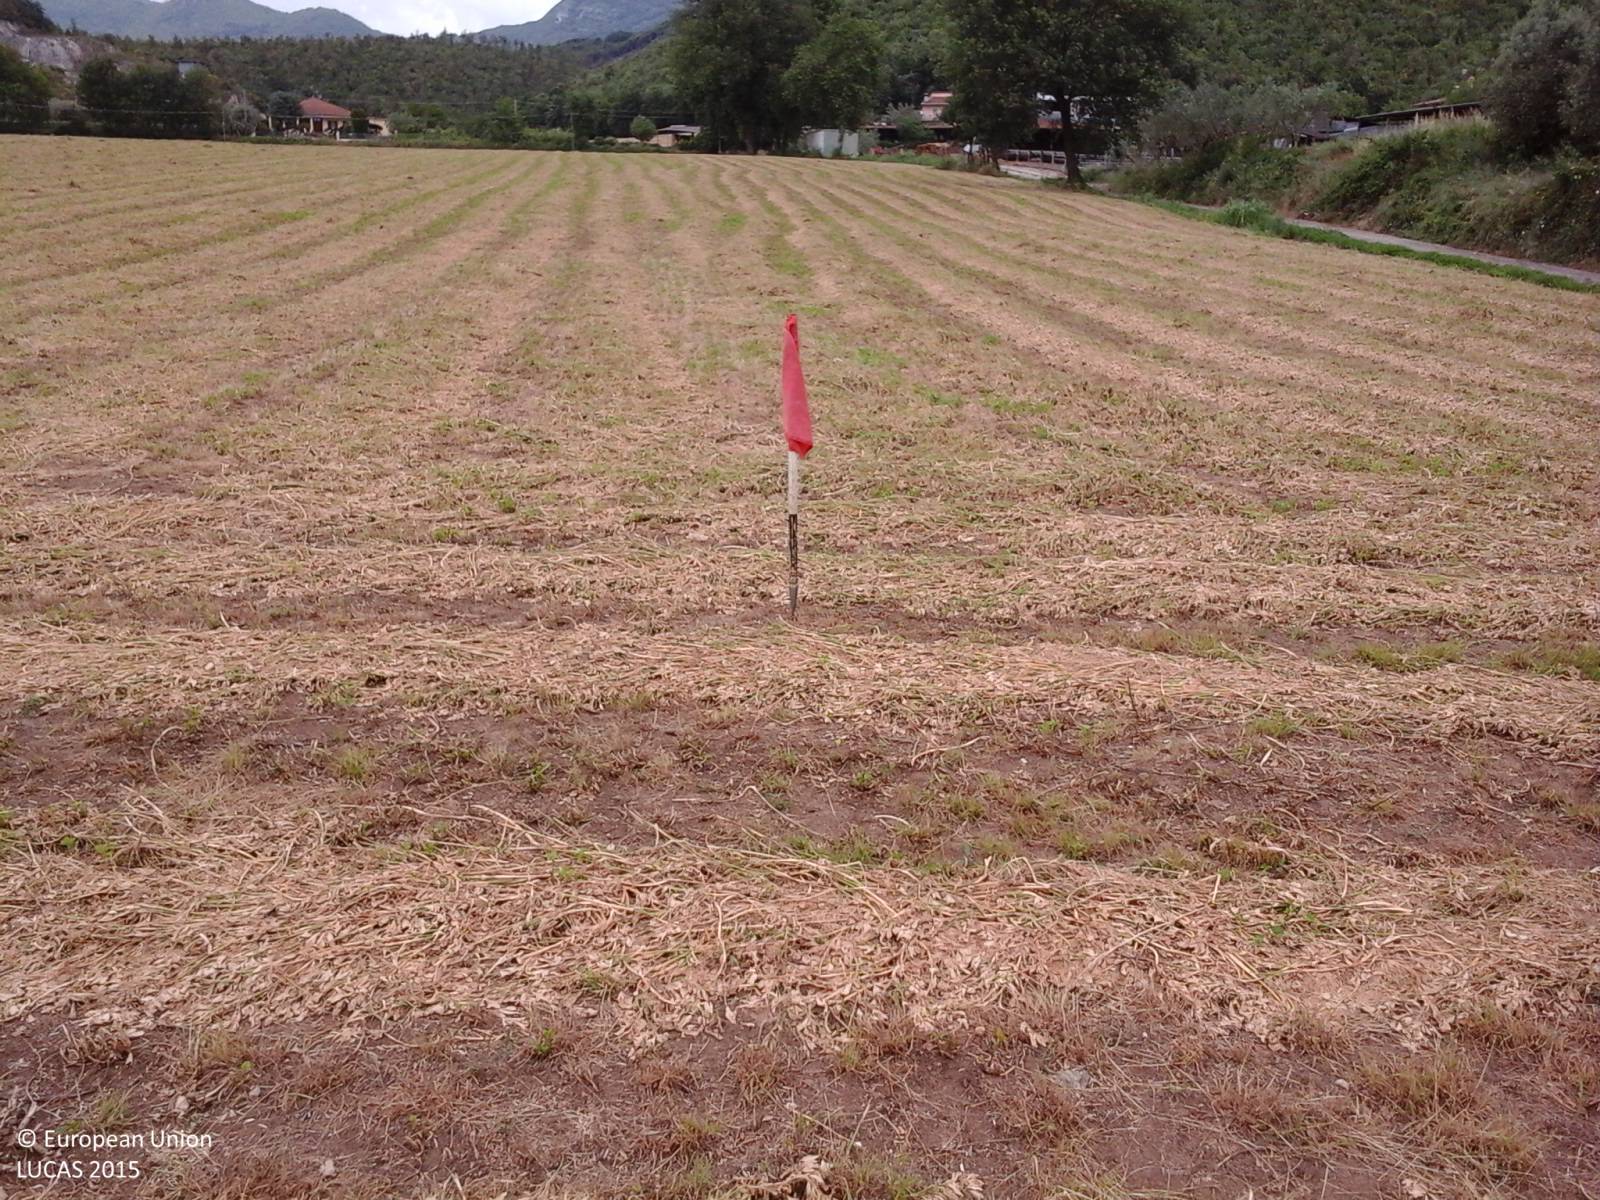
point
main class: Cropland
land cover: Lucerne
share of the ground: > 75 %
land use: Agriculture (excluding fallow land and kitchen gardens)
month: May
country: IT
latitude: 41.1891
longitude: 14.2636
